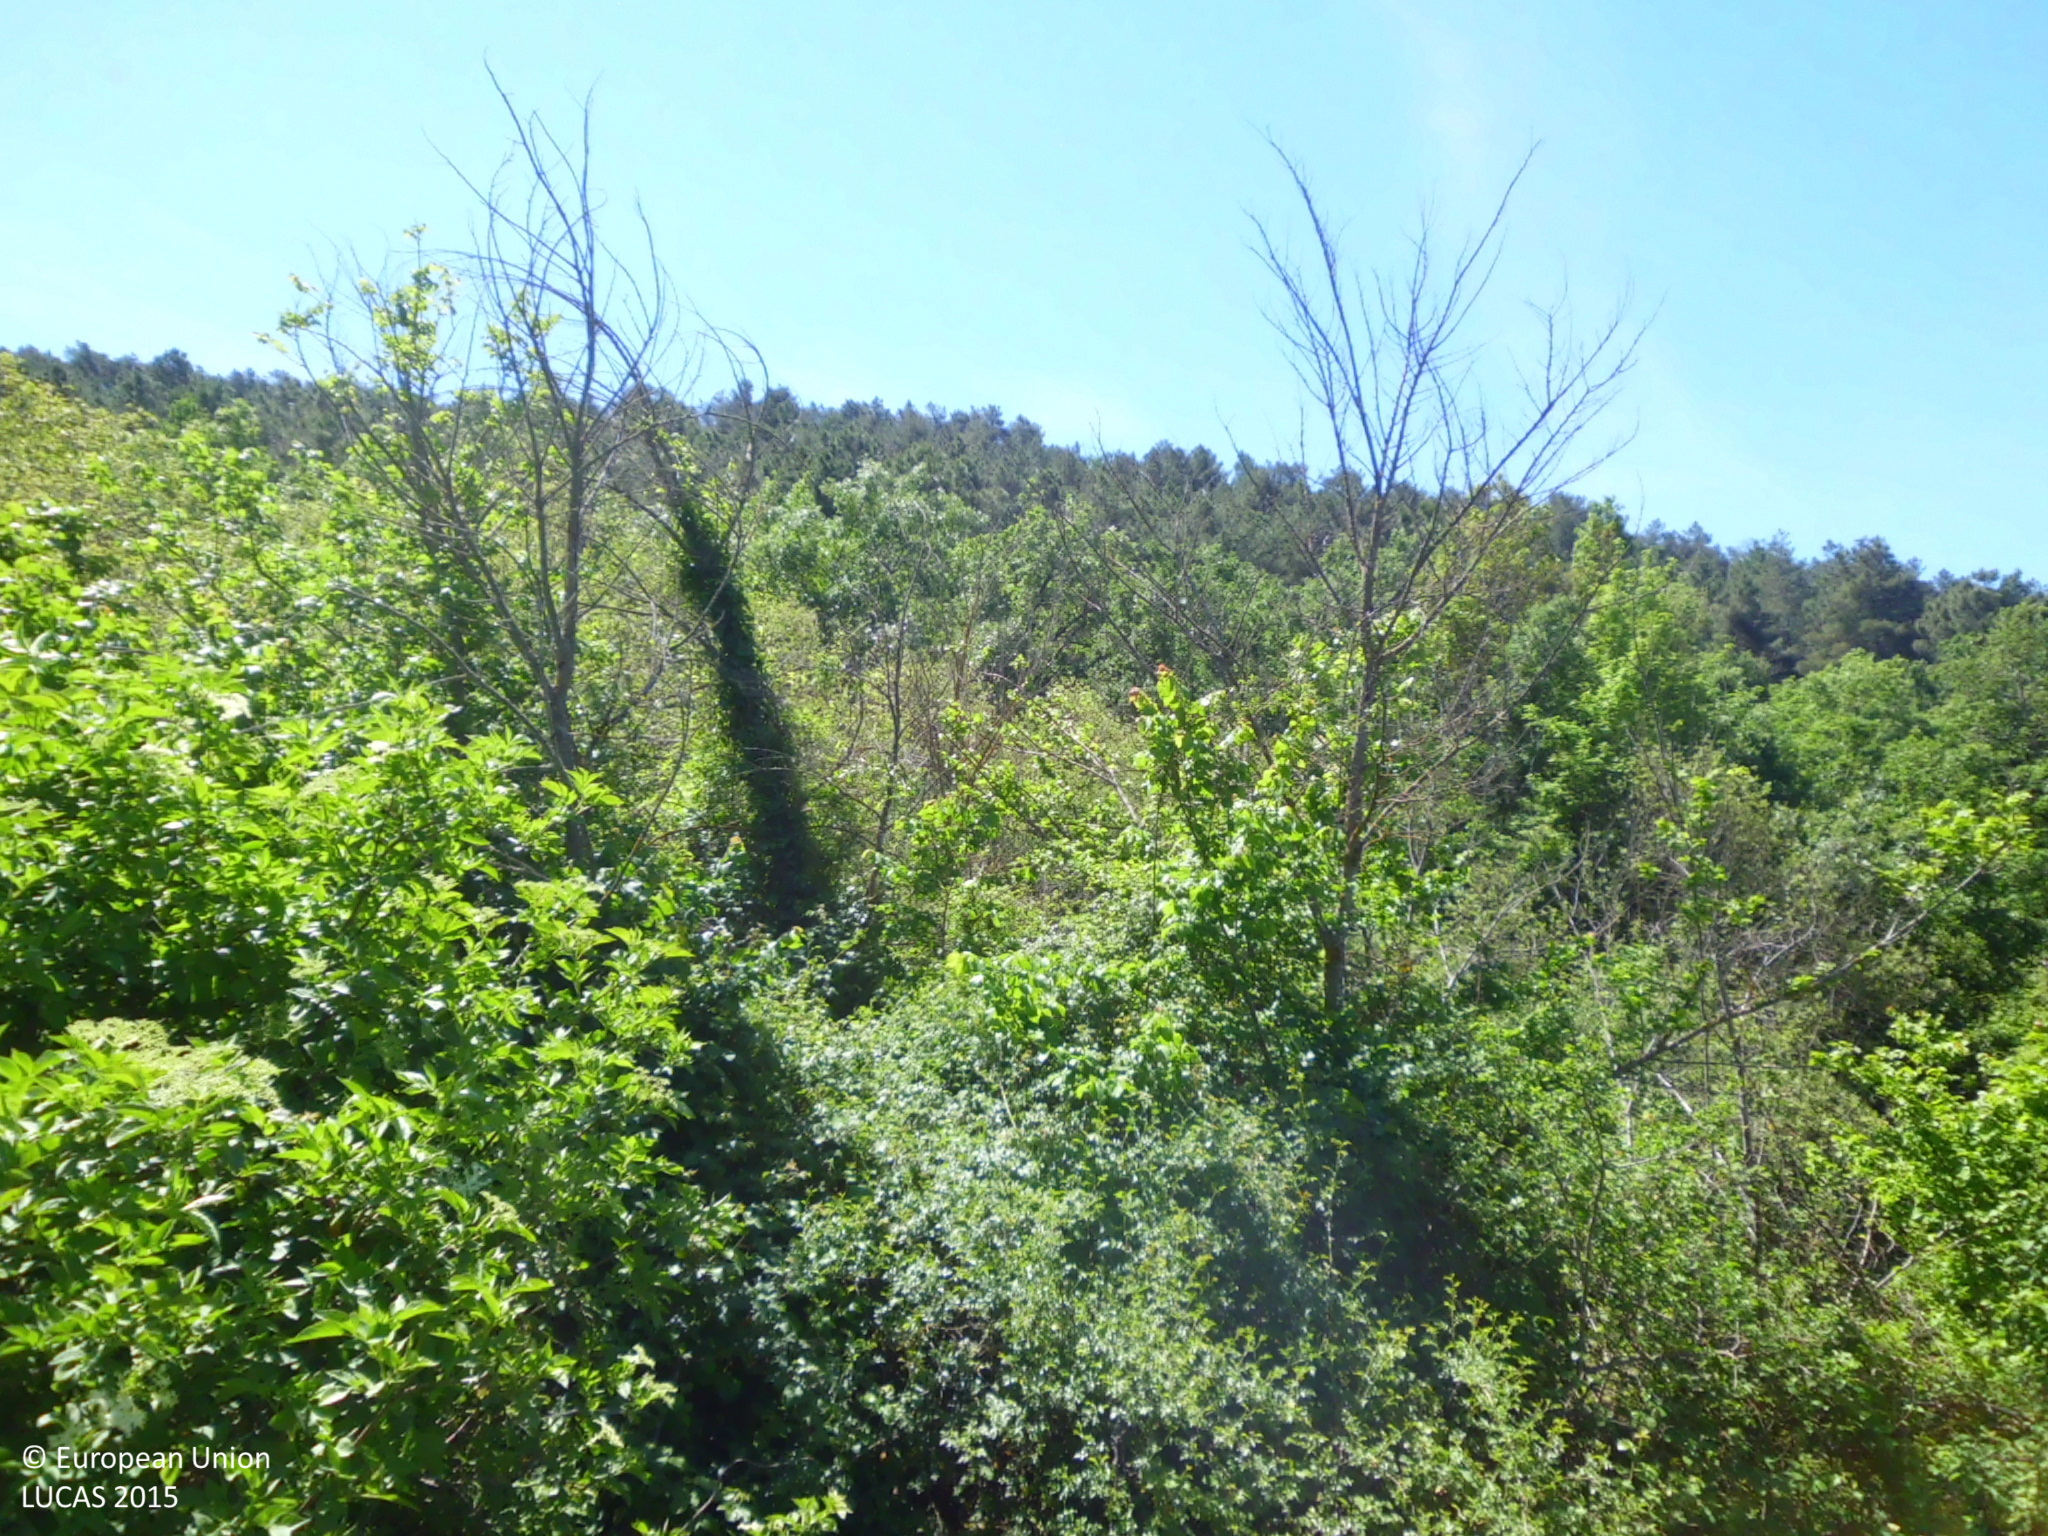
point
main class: Woodland
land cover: Other mixed woodland
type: acidophilous oak and oak-birch forest
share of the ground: > 75 %
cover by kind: broadleaved forest trees 60 %, coniferous forest trees 20 %, shrubs 20 %
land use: Semi-natural and natural areas not in use
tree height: > 5 m
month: May
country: ES
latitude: 42.7058
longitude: -3.4288
